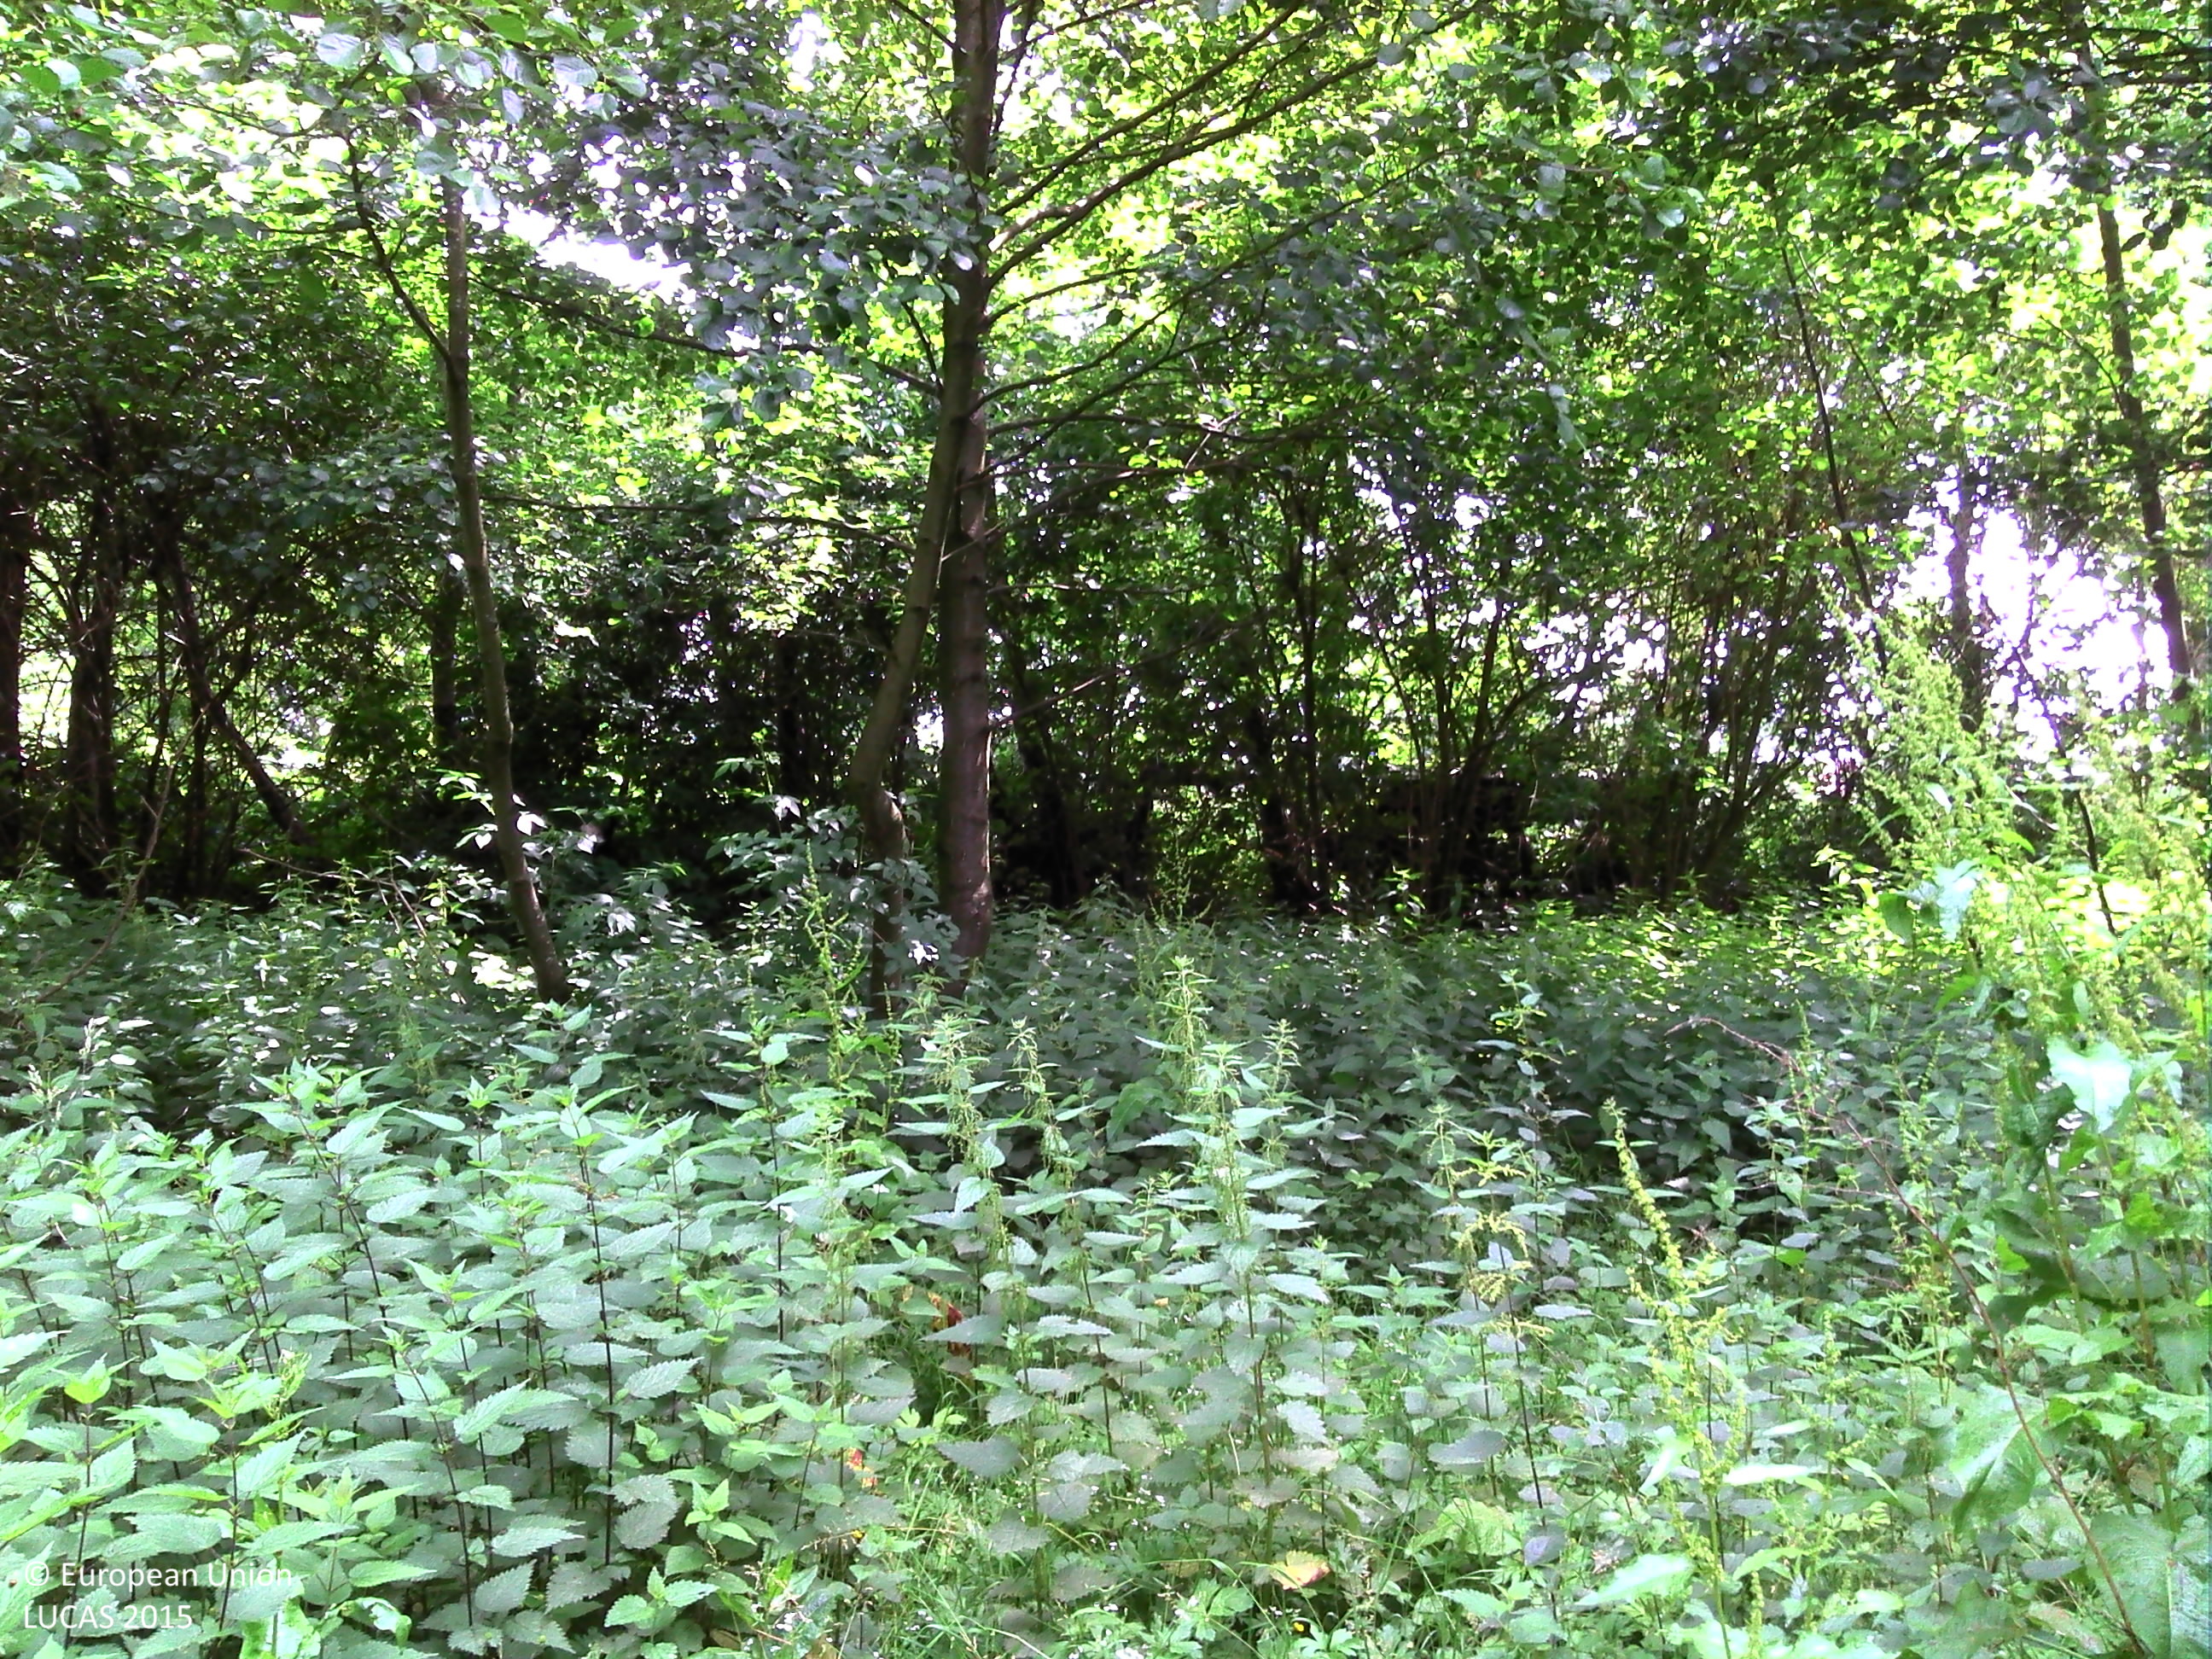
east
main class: Woodland
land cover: Broadleaved woodland
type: non-riverine alder, birch or aspen forest
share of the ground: > 75 %
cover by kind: broadleaved forest trees 60 %, herbaceous plants 40 %
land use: Semi-natural and natural areas not in use
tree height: > 5 m
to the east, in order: Broadleaved woodland; Ditches and canals; Broadleaved woodland; Ditches and canals; Lines of trees; Fences; Maize; Fences; Lines of trees; Ditches and canals; Grass margins; Paved roads, cycling and walking lanes; Grass margins; Fences; Grassland without tree/shrub cover
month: June
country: BE
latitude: 51.1800
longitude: 5.6066
